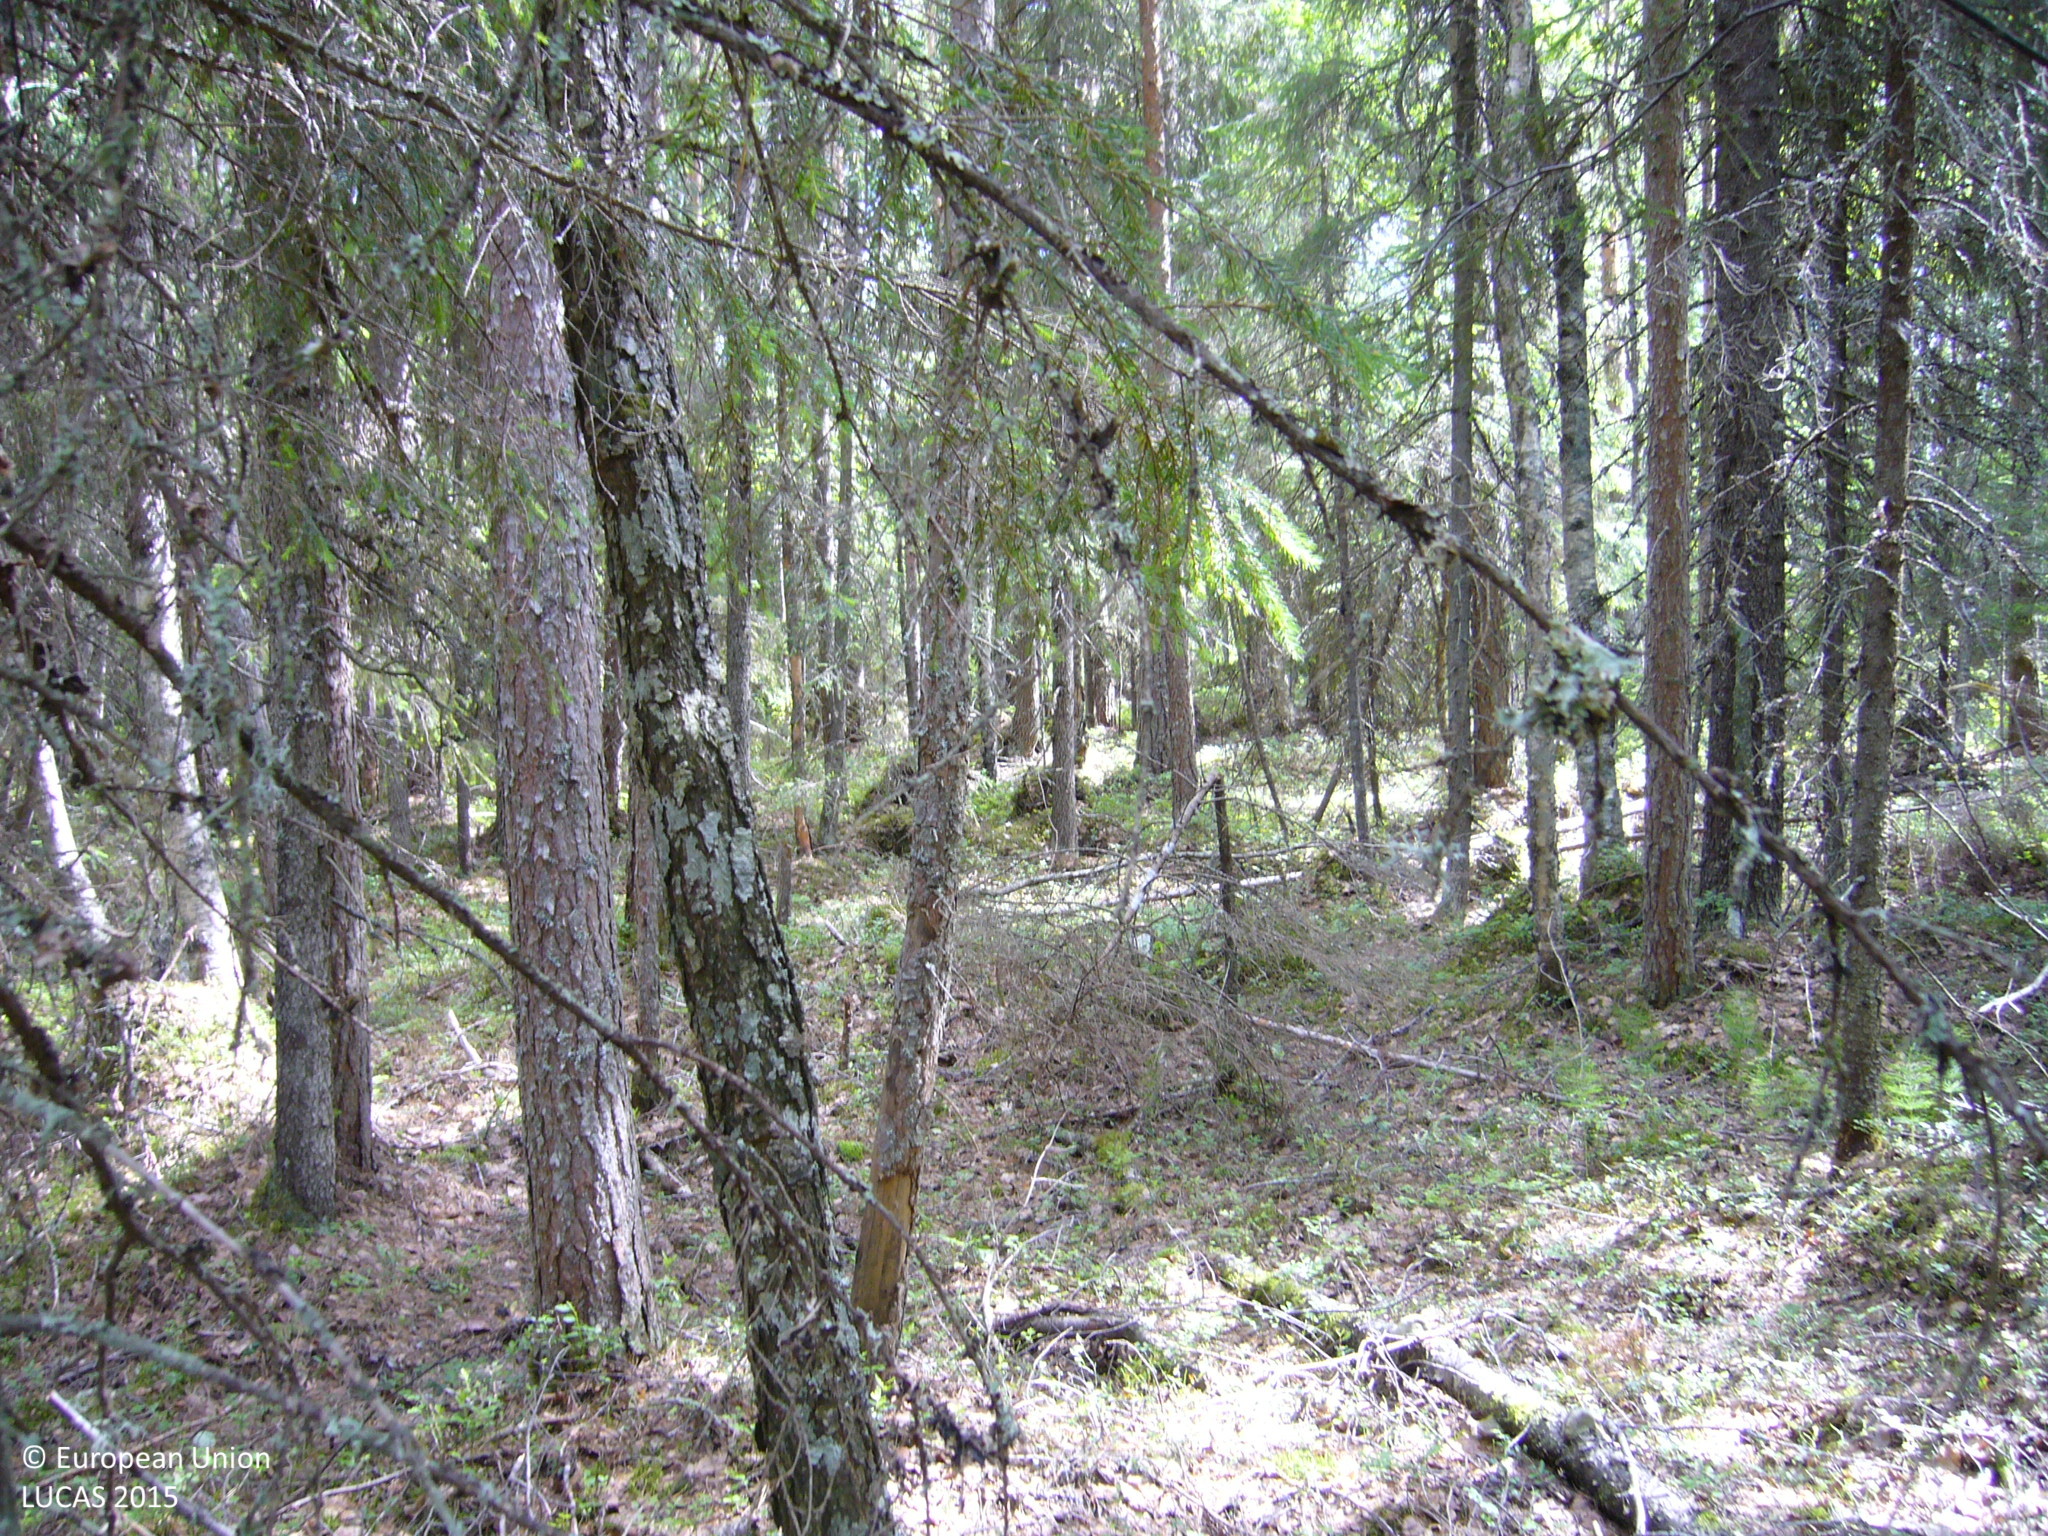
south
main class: Woodland
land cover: Spruce dominated mixed woodland
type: boreal forest
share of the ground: > 75 %
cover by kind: coniferous forest trees 60 %, broadleaved forest trees 30 %, shrubs 10 %
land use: Forestry
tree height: > 5 m
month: July
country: FI
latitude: 63.3144
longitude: 26.3920
